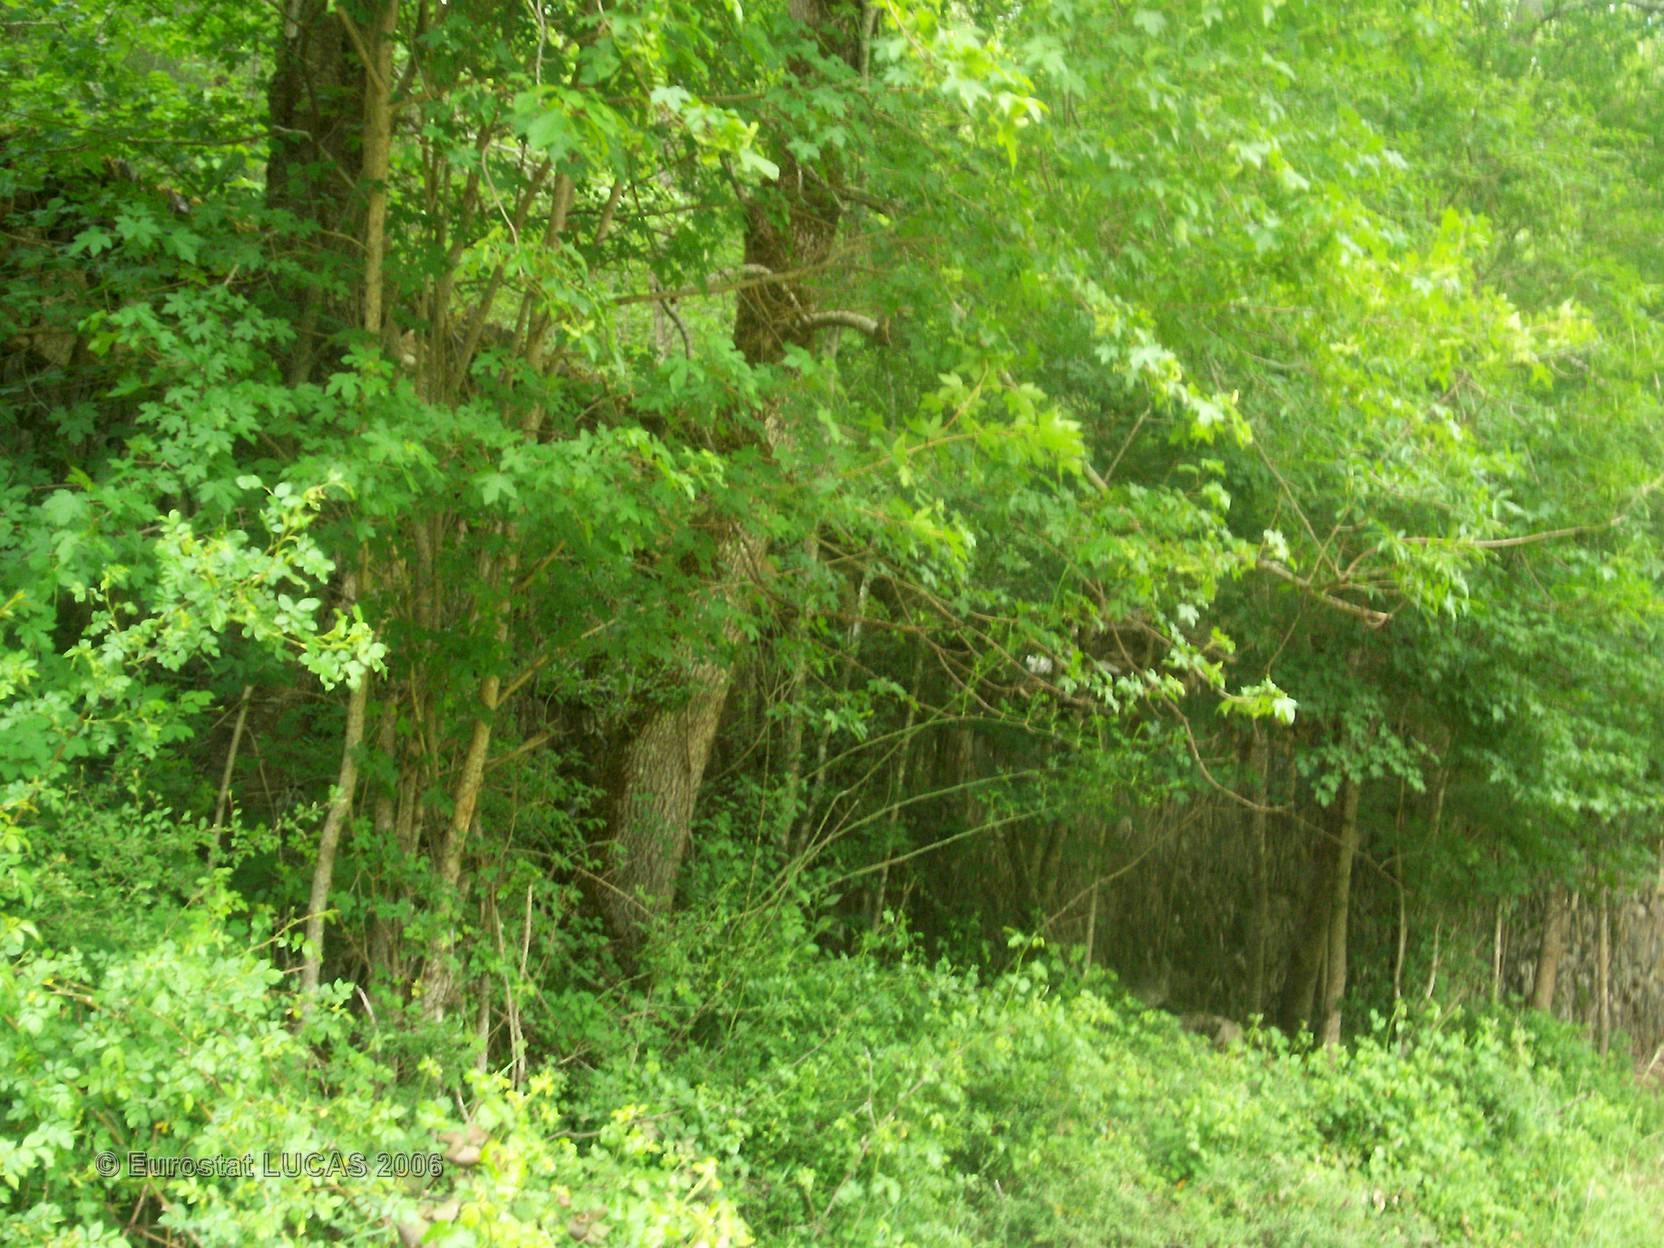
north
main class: Grassland
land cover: Grassland without tree/shrub cover
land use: Agriculture (excluding fallow land and kitchen gardens)
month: June
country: FR
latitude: 44.5202
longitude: 3.3998
